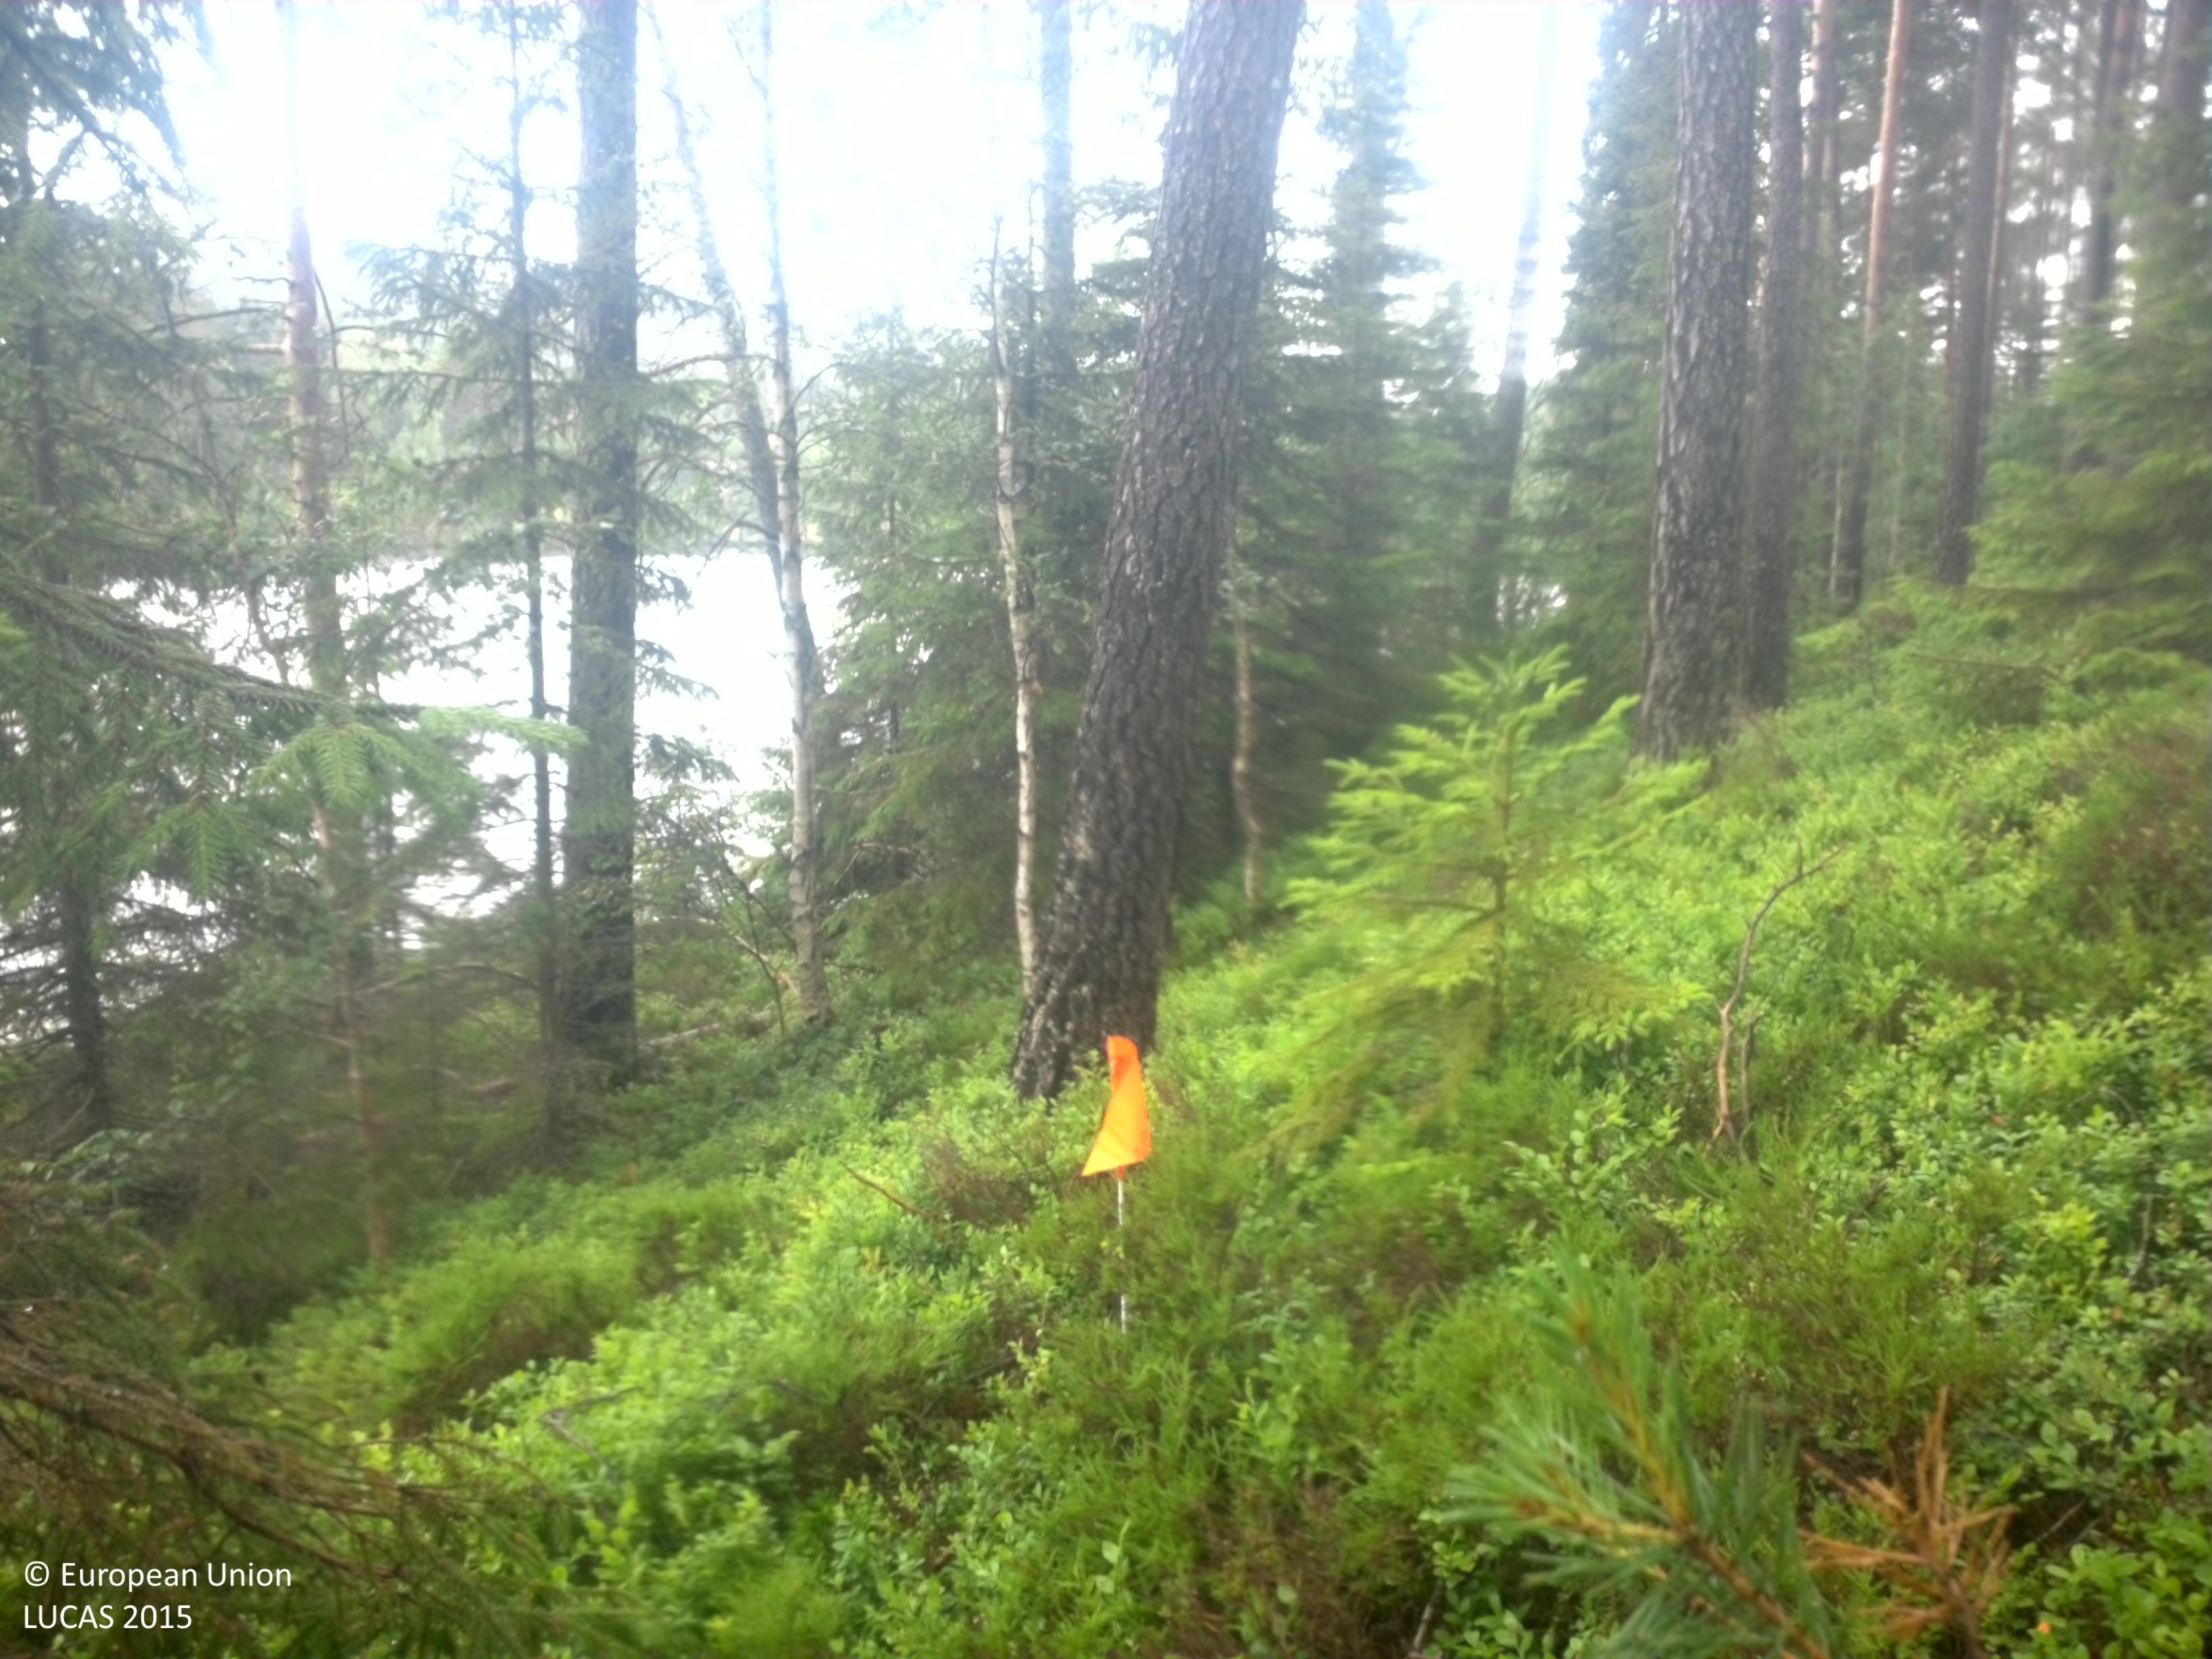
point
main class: Woodland
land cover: Pine dominated coniferous woodland
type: boreal forest
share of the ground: 50 - 75 %
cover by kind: coniferous forest trees 55 %, shrubs 35 %, broadleaved forest trees 5 %, lichens and mosses 5 %
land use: Forestry
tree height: > 5 m
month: July
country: SE
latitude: 59.6408
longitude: 14.4784
